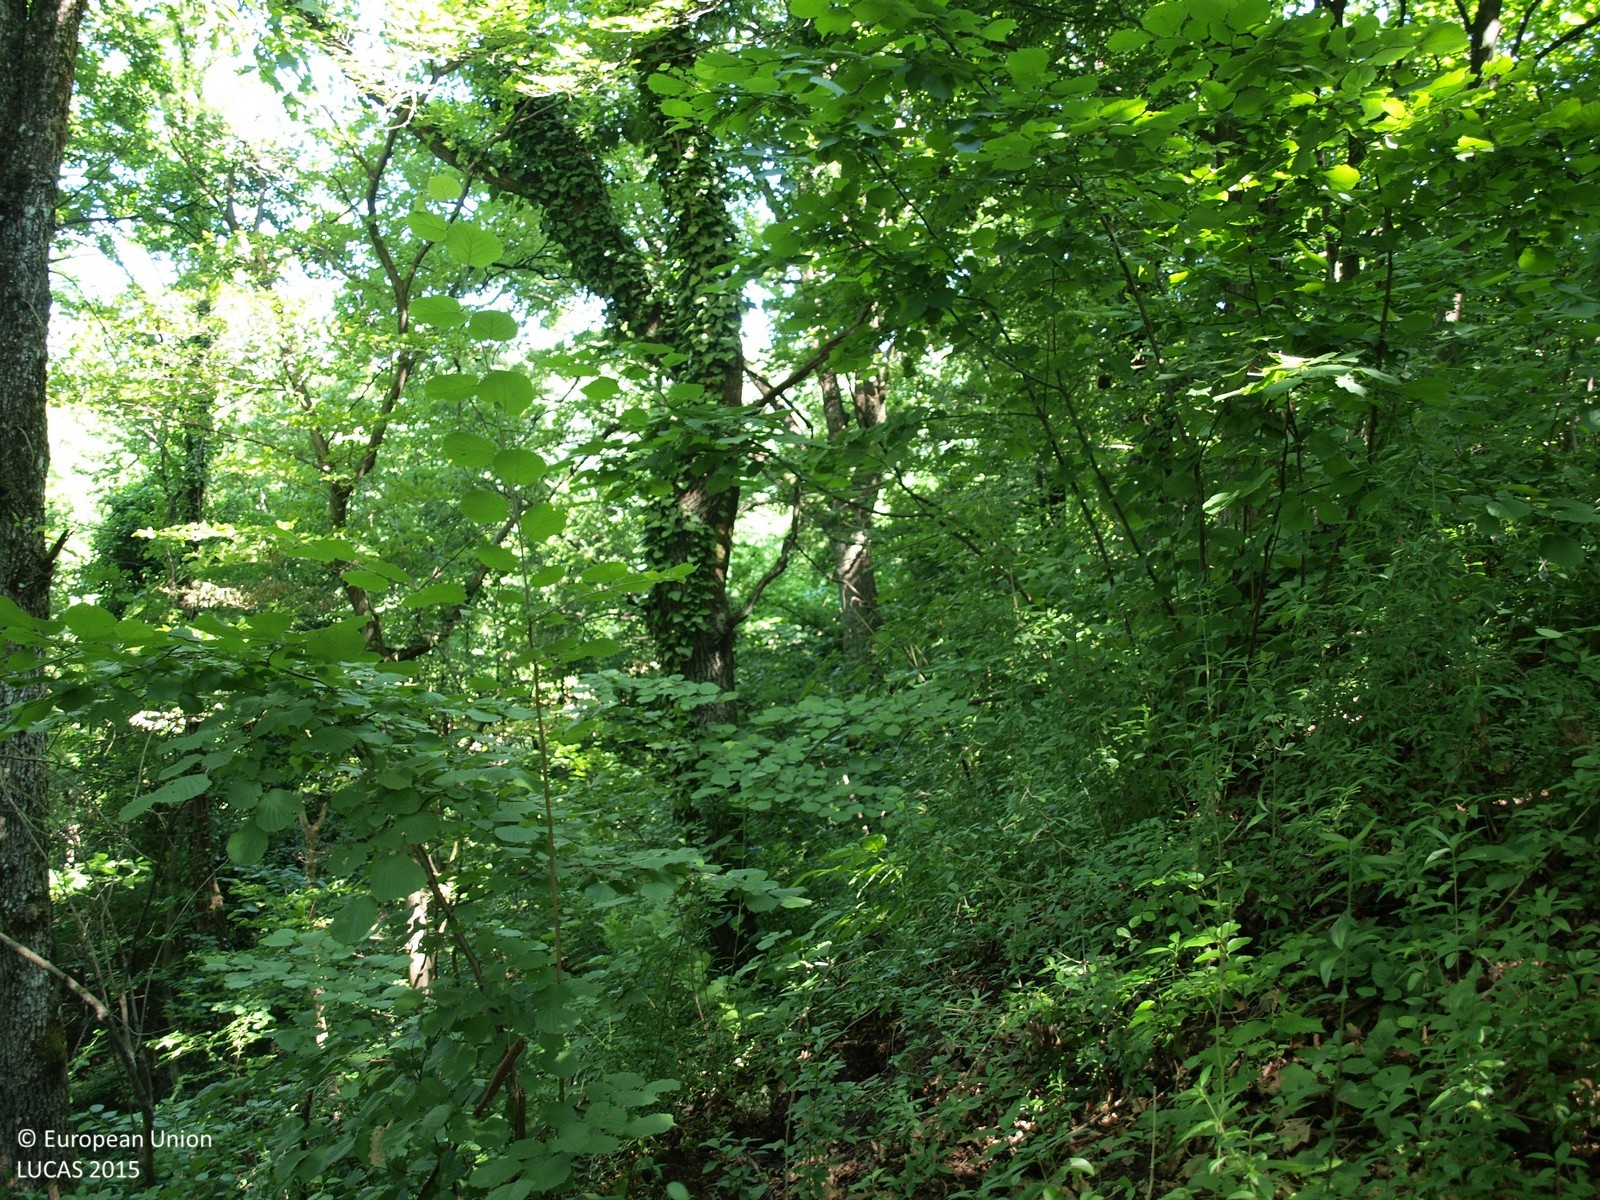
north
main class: Woodland
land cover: Broadleaved woodland
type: mesophytic deciduous forest
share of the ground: > 75 %
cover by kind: broadleaved forest trees 100 %
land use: Forestry
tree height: > 5 m
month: June
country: HR
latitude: 46.1612
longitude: 15.7352
